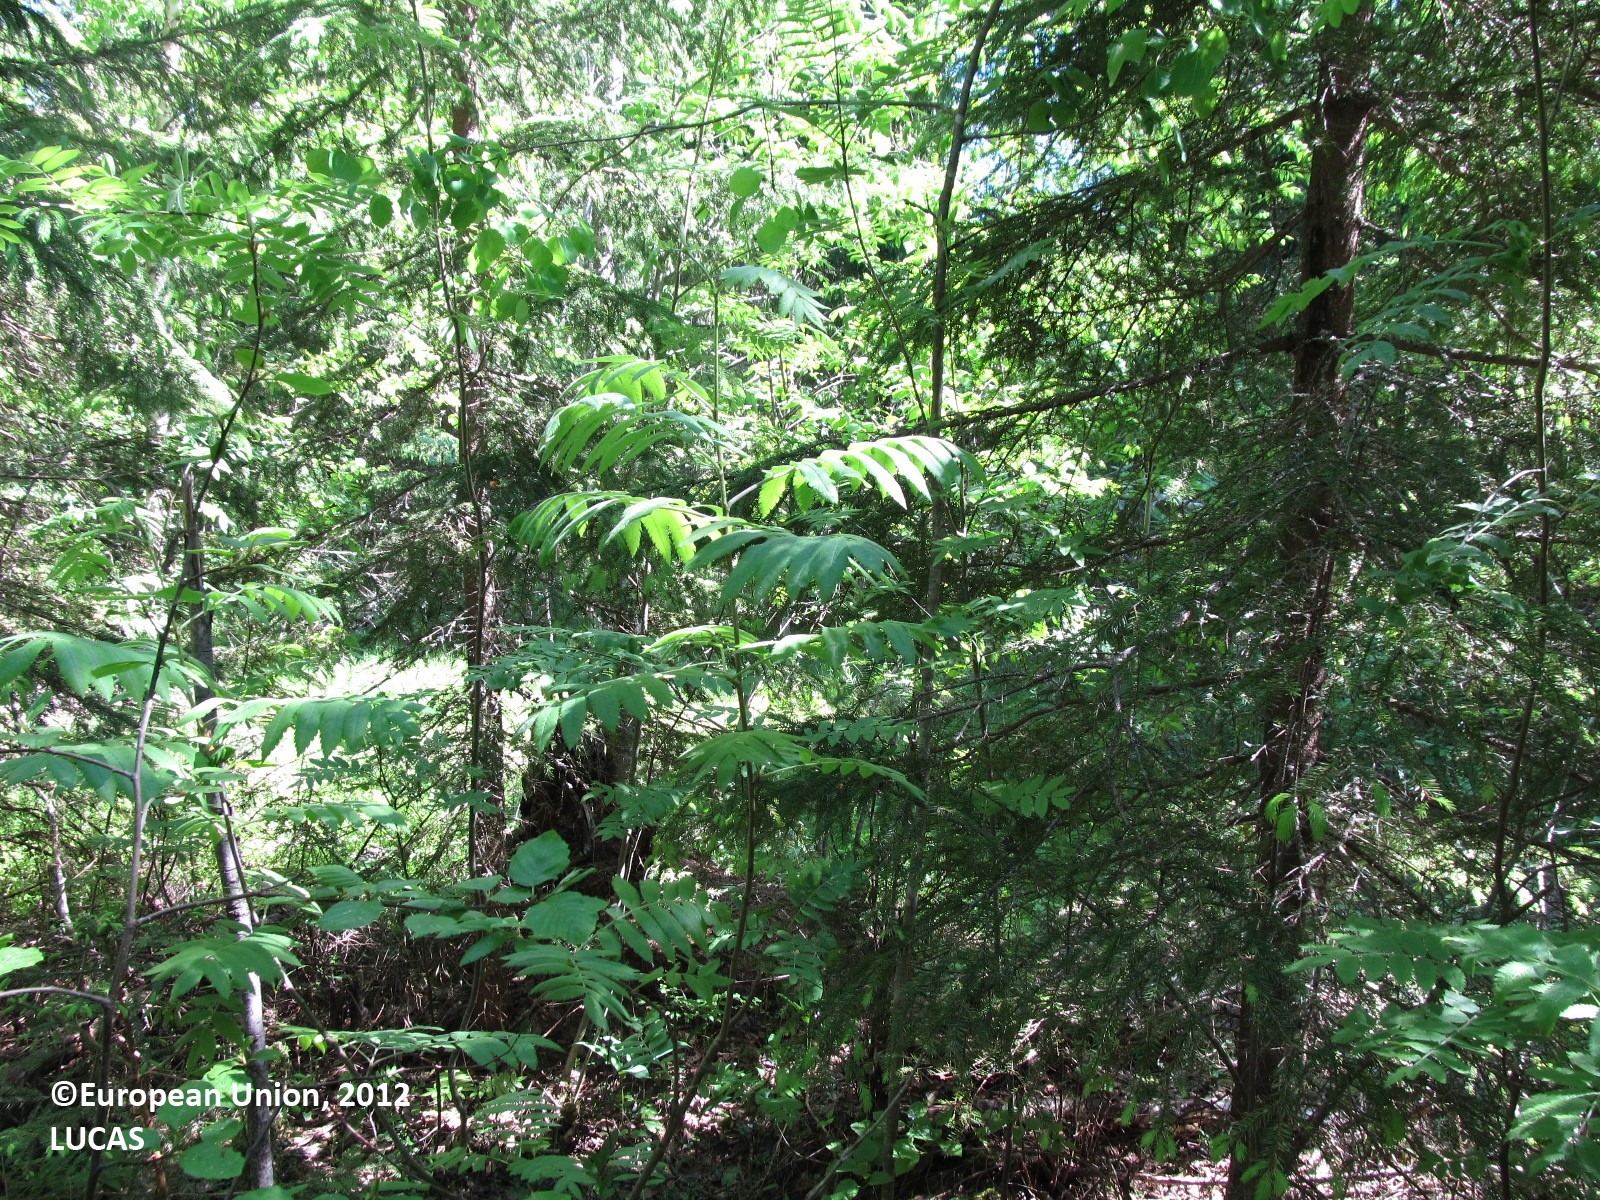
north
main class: Woodland
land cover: Spruce dominated mixed woodland
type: boreal forest
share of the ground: > 75 %
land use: Forestry
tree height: > 5 m
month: June
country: FI
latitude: 62.7197
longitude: 27.3907
